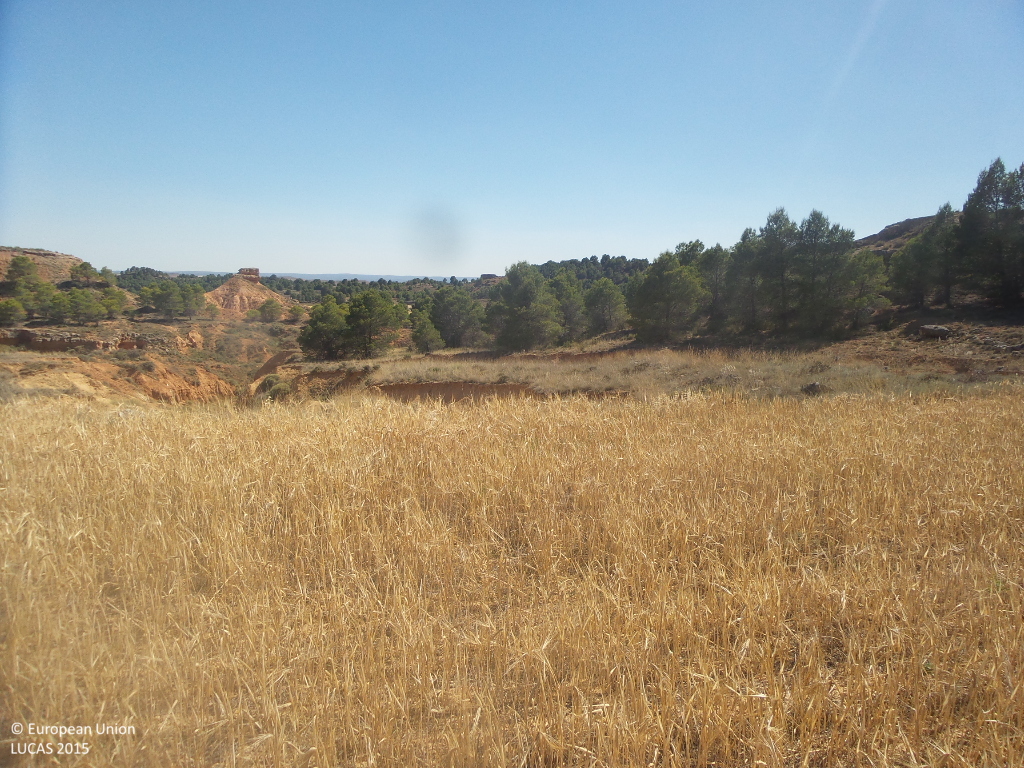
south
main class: Cropland
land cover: Barley
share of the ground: > 75 %
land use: Agriculture (excluding fallow land and kitchen gardens)
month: July
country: ES
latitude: 41.3255
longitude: -2.0842
